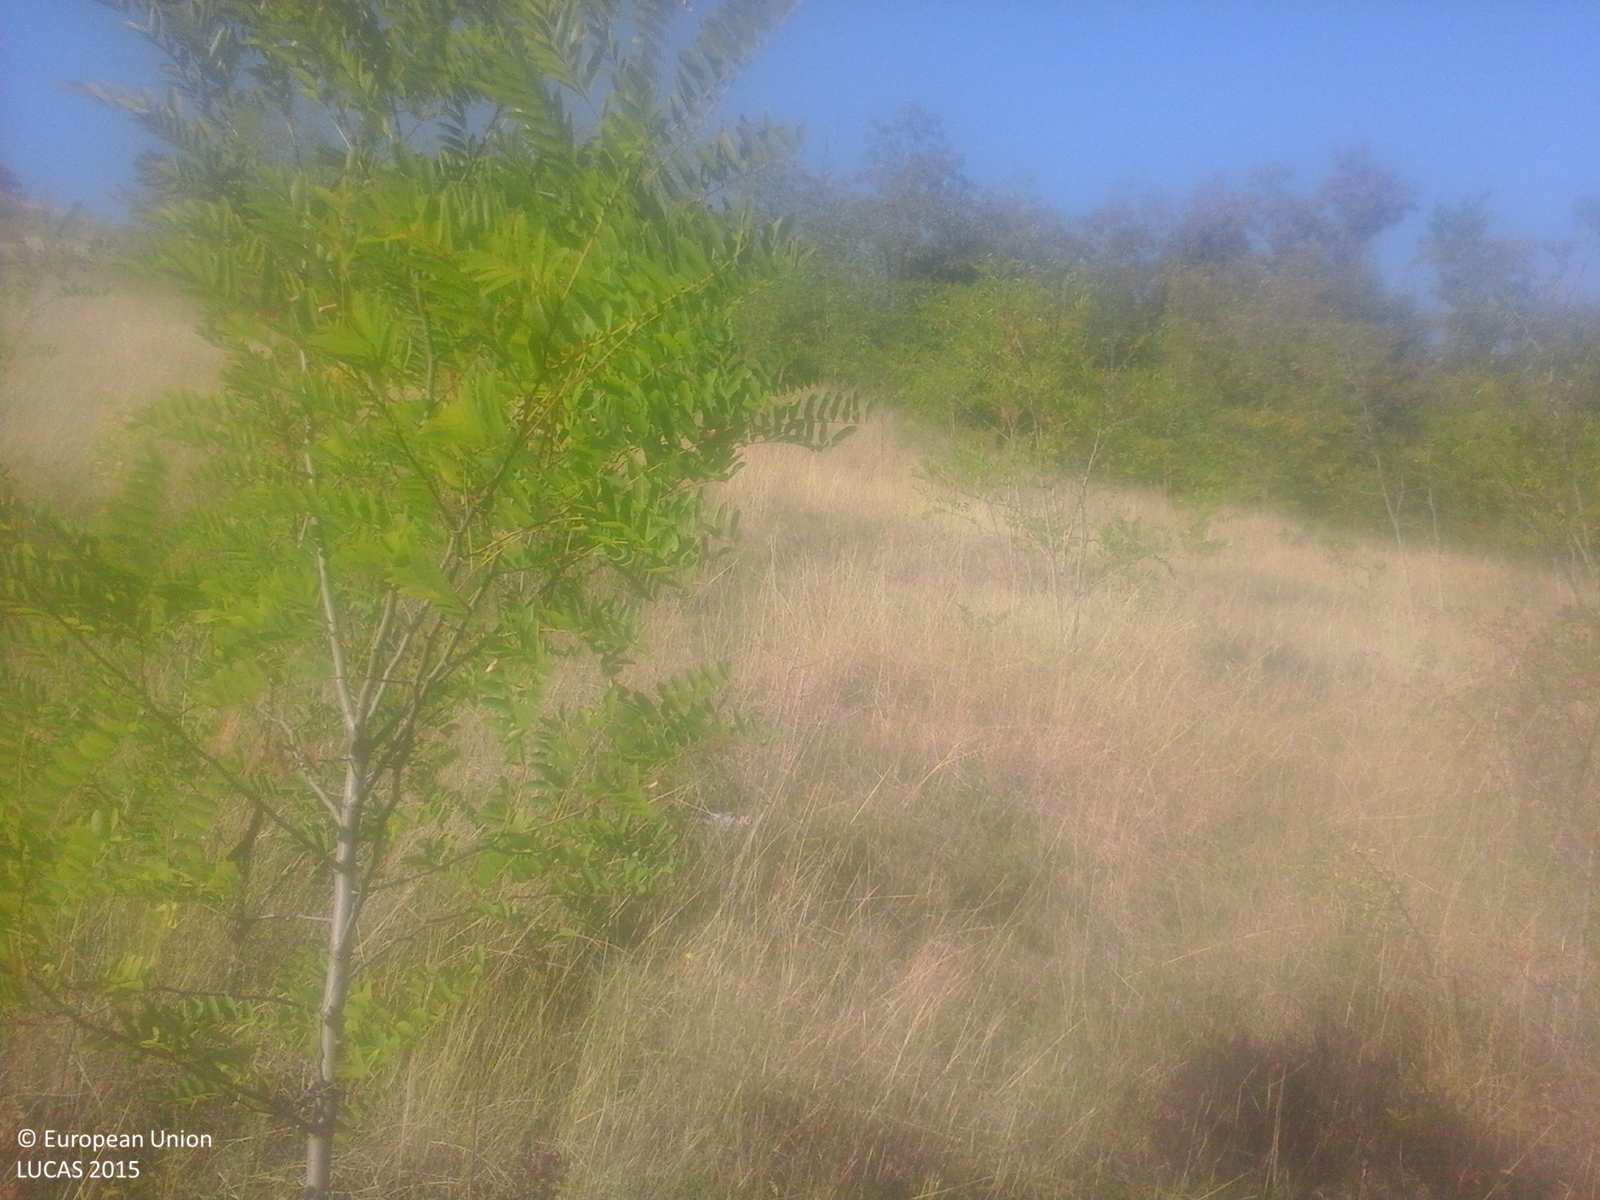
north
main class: Grassland
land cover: Grassland with sparse tree/shrub cover
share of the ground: > 75 %
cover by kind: herbaceous plants 85 %, shrubs 10 %, broadleaved forest trees 5 %
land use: Agriculture (excluding fallow land and kitchen gardens)
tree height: < 5 m
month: October
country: RO
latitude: 46.4603
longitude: 23.6243
